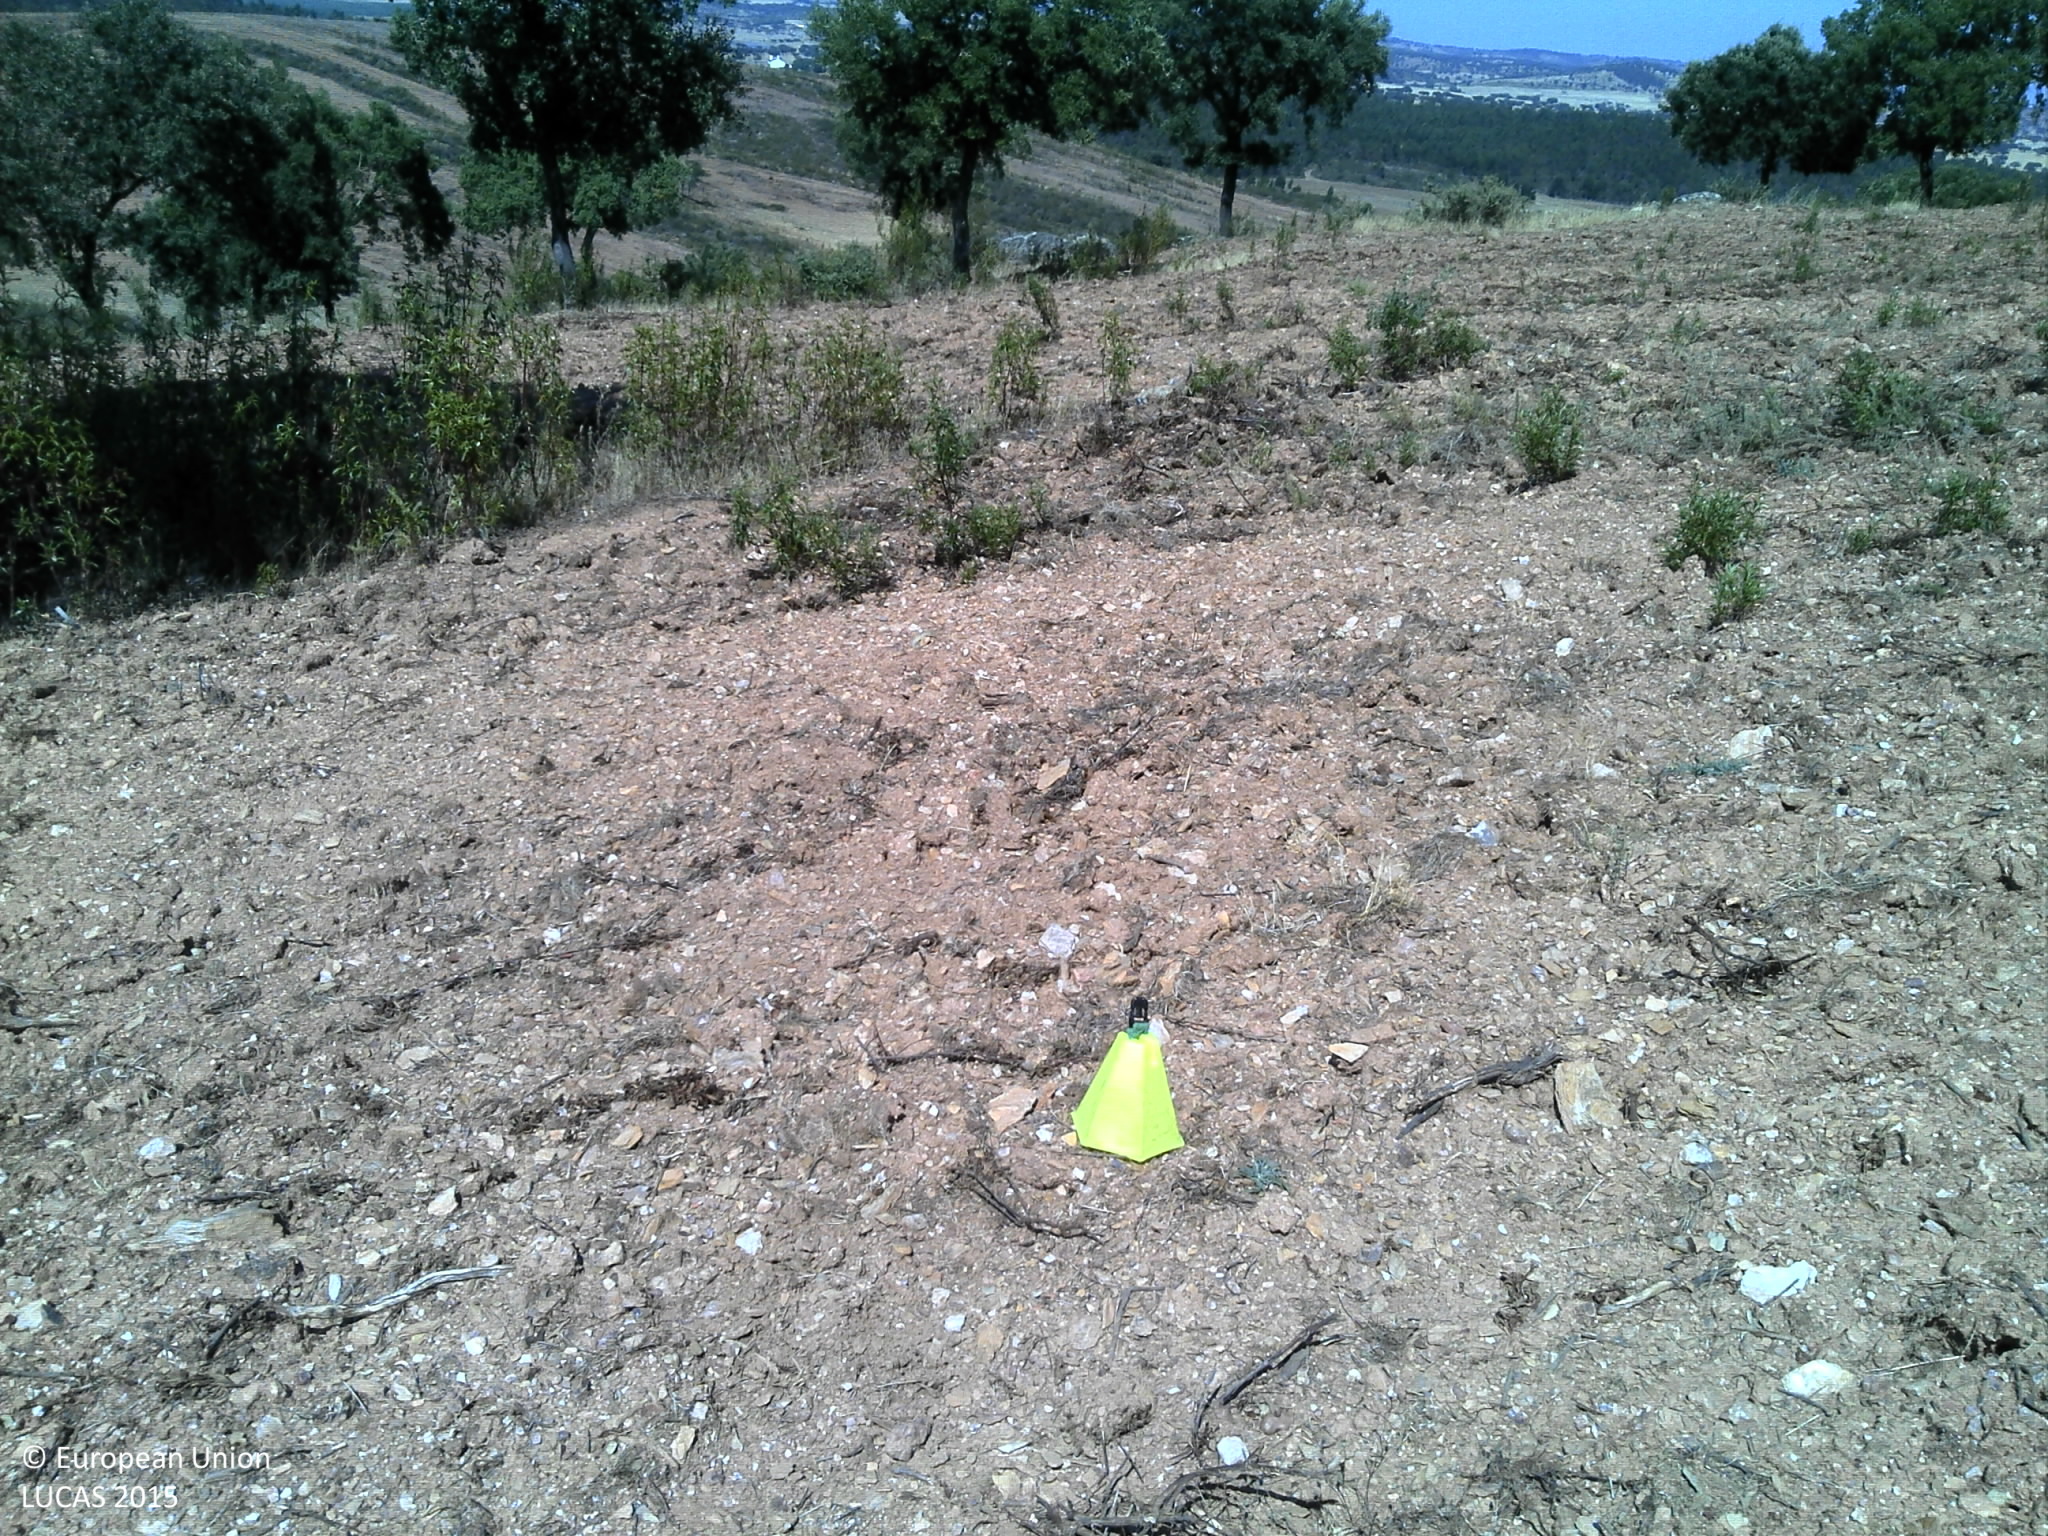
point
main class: Woodland
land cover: Broadleaved woodland
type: broadleaved evergreen forest
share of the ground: 10 - 25 %
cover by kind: unconsolidated bare surface 85 %, broadleaved forest trees 15 %
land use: Forestry
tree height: > 5 m
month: July
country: PT
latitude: 38.6994
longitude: -7.4980
